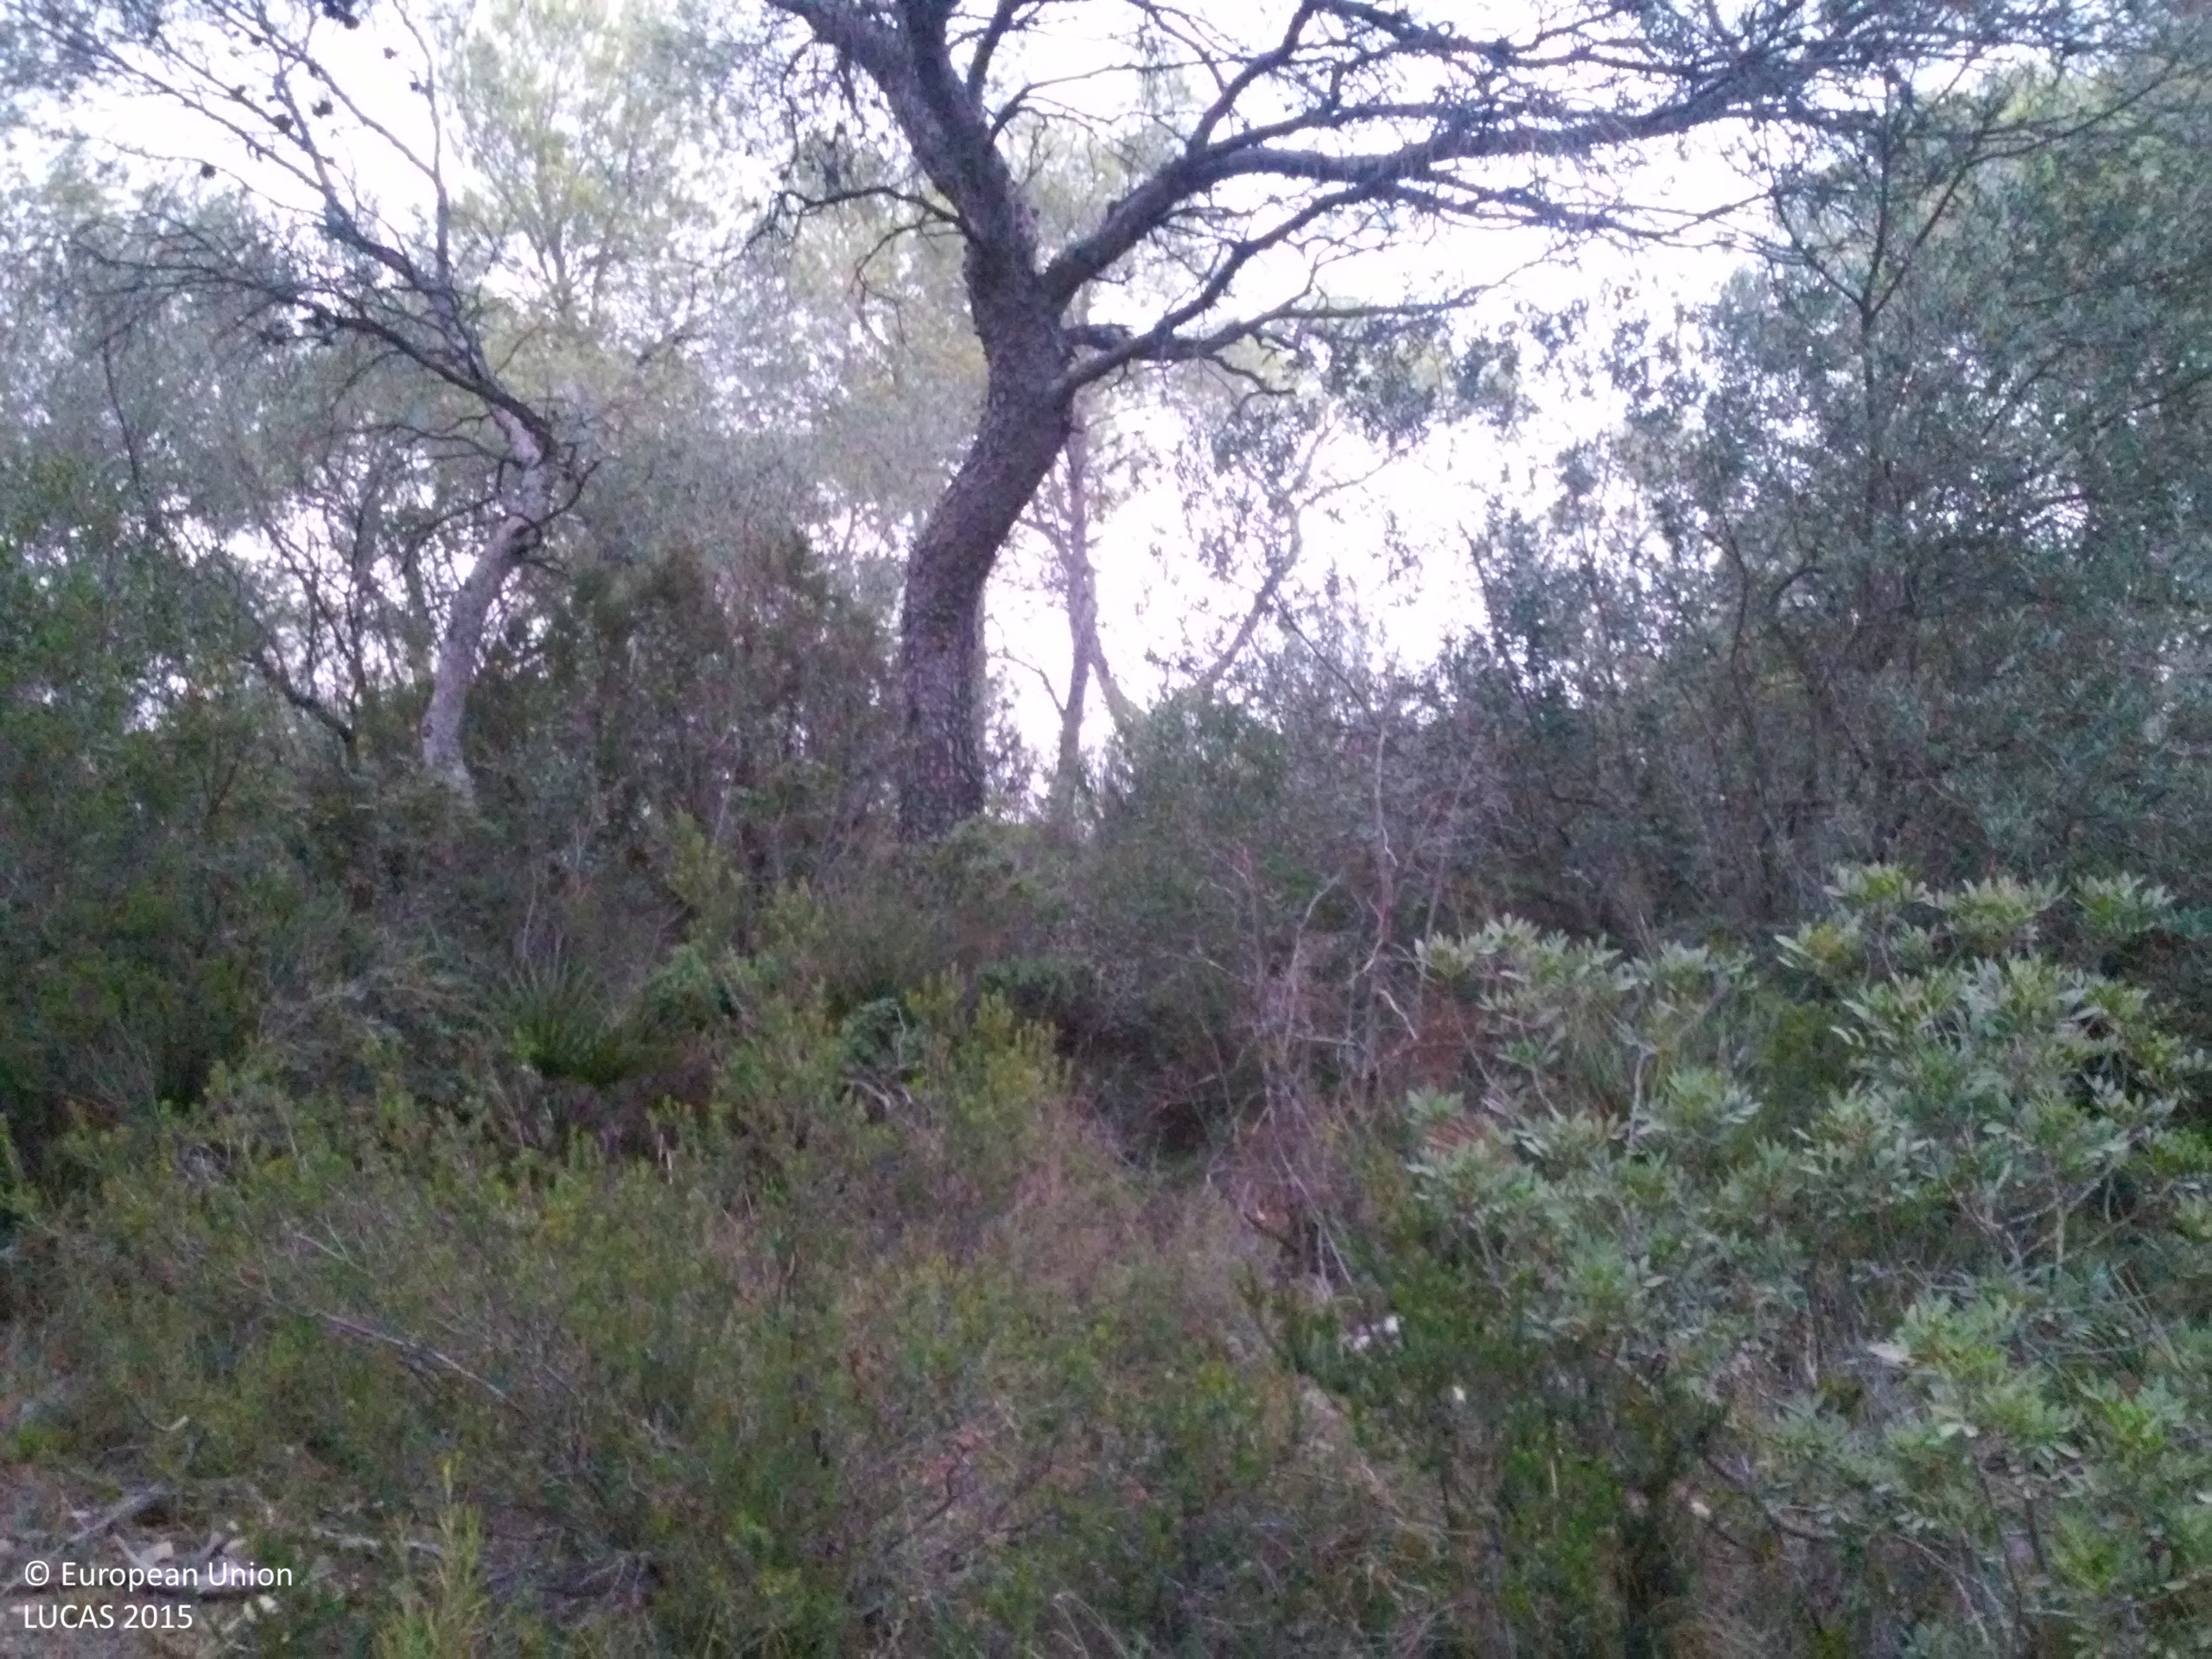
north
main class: Woodland
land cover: Pine dominated coniferous woodland
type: coniferous forest of the mediterranean region
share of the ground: 10 - 25 %
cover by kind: shrubs 50 %, herbaceous plants 30 %, coniferous forest trees 20 %
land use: Semi-natural and natural areas not in use
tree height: > 5 m
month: August
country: ES
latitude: 41.0104
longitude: 0.5394
